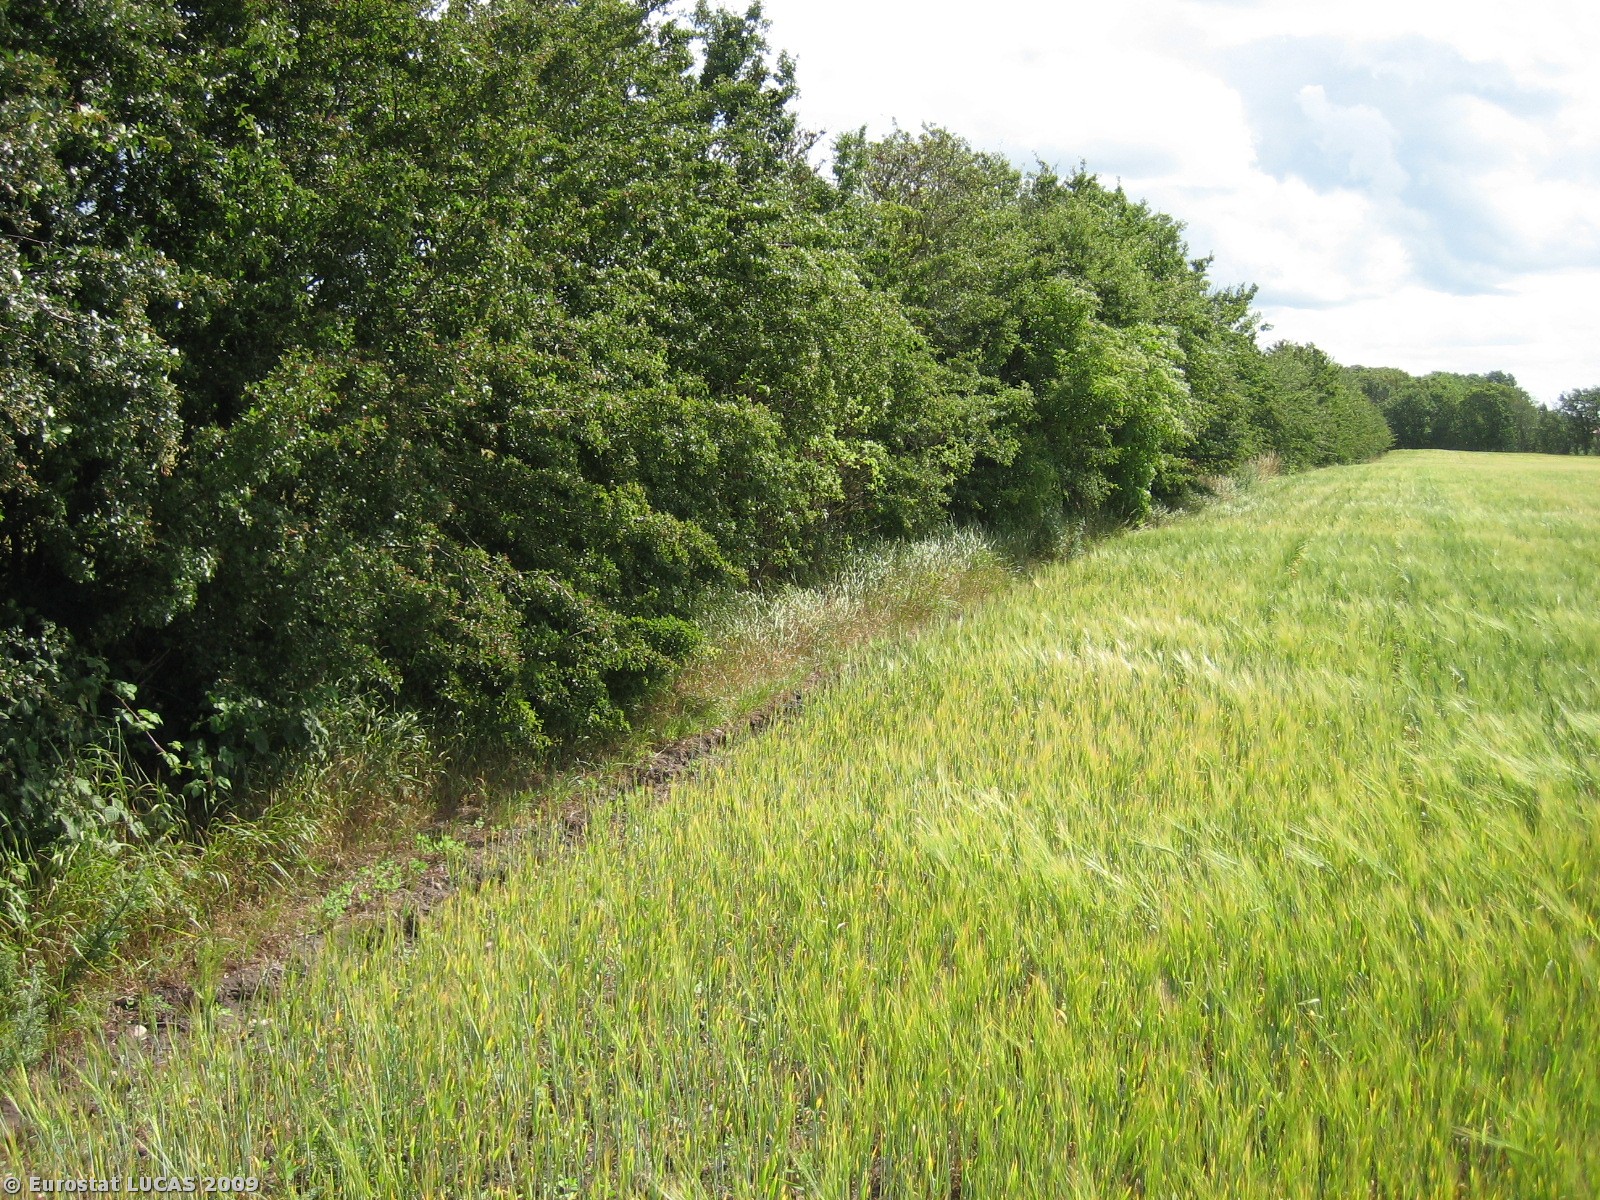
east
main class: Cropland
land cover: Barley
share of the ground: > 75 %
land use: Agriculture (excluding fallow land and kitchen gardens)
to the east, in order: Barley; Abandoned hedges; Common wheat; Grass margins; Paved roads, cycling and walking lanes; Grass margins; Managed hedges; Grassland without tree/shrub cover
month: July
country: DK
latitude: 55.7481
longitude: 8.5517
